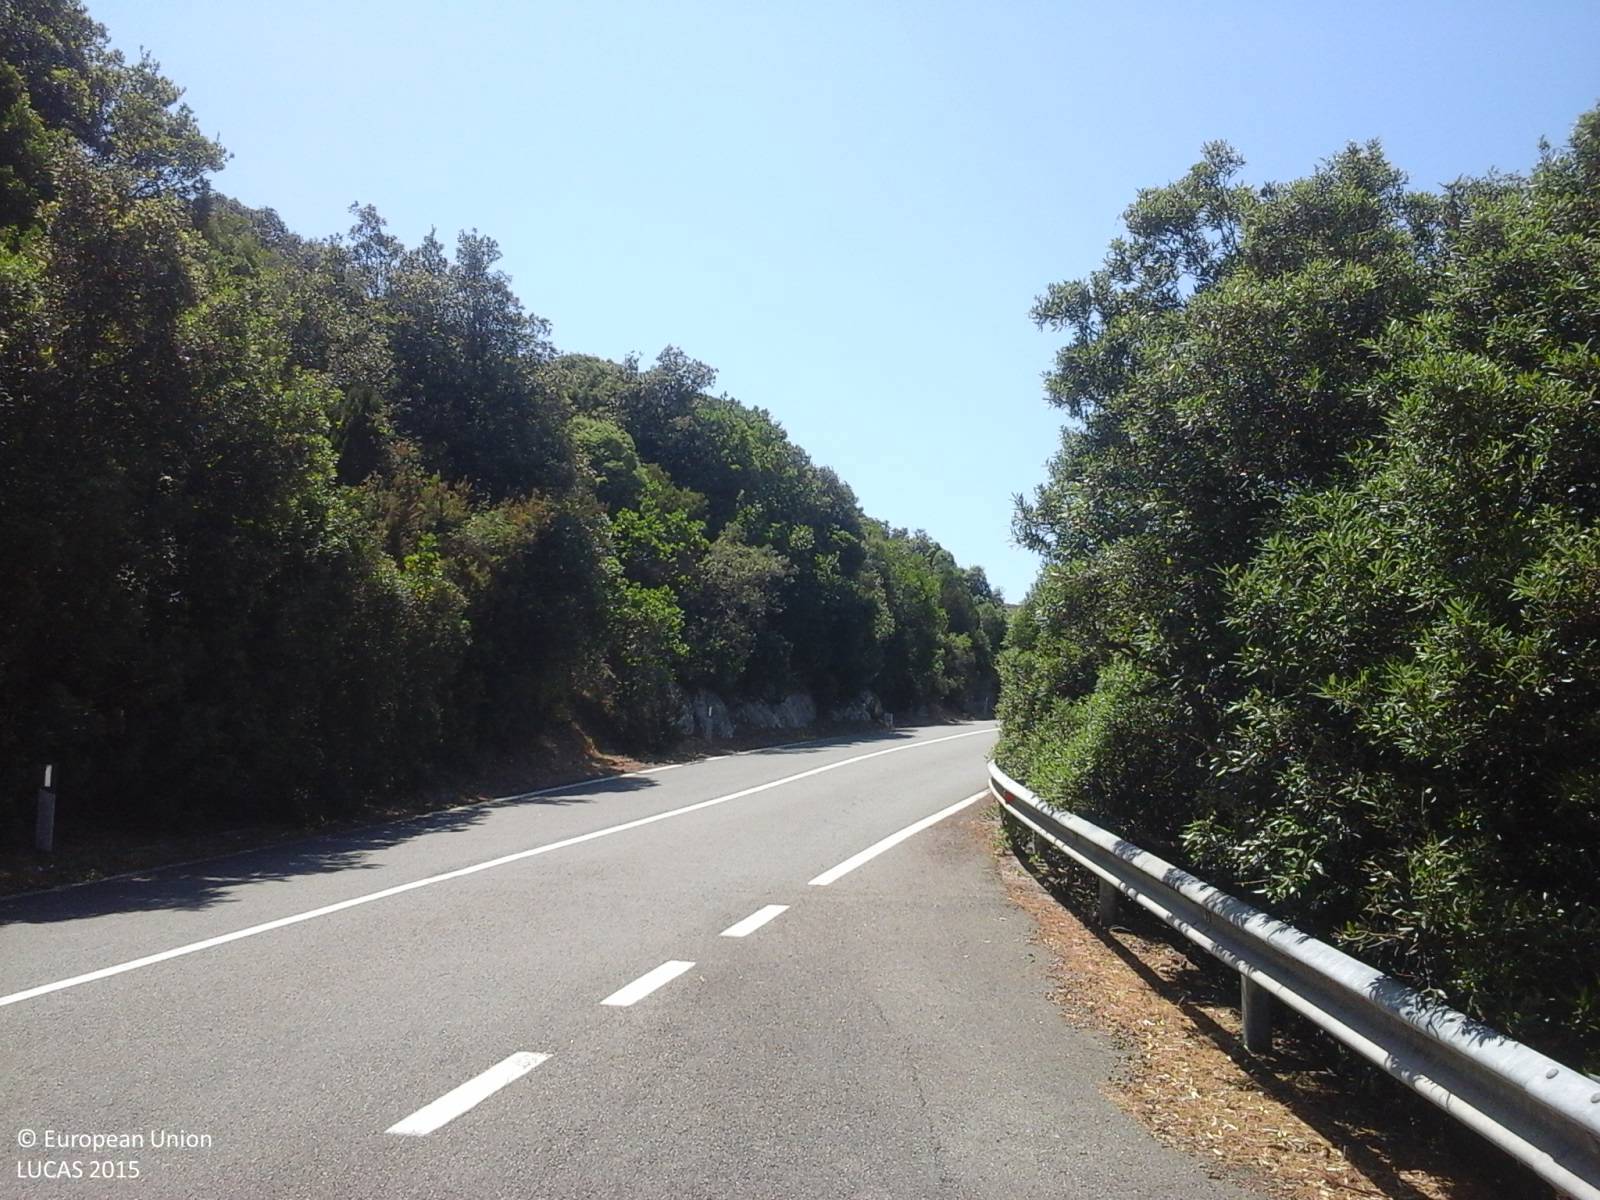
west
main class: Woodland
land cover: Broadleaved woodland
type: broadleaved evergreen forest
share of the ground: > 75 %
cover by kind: broadleaved forest trees 60 %, shrubs 25 %, coniferous forest trees 10 %, herbaceous plants 5 %
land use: Agriculture (excluding fallow land and kitchen gardens)
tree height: > 5 m
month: June
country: IT
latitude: 38.9377
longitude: 8.8194
